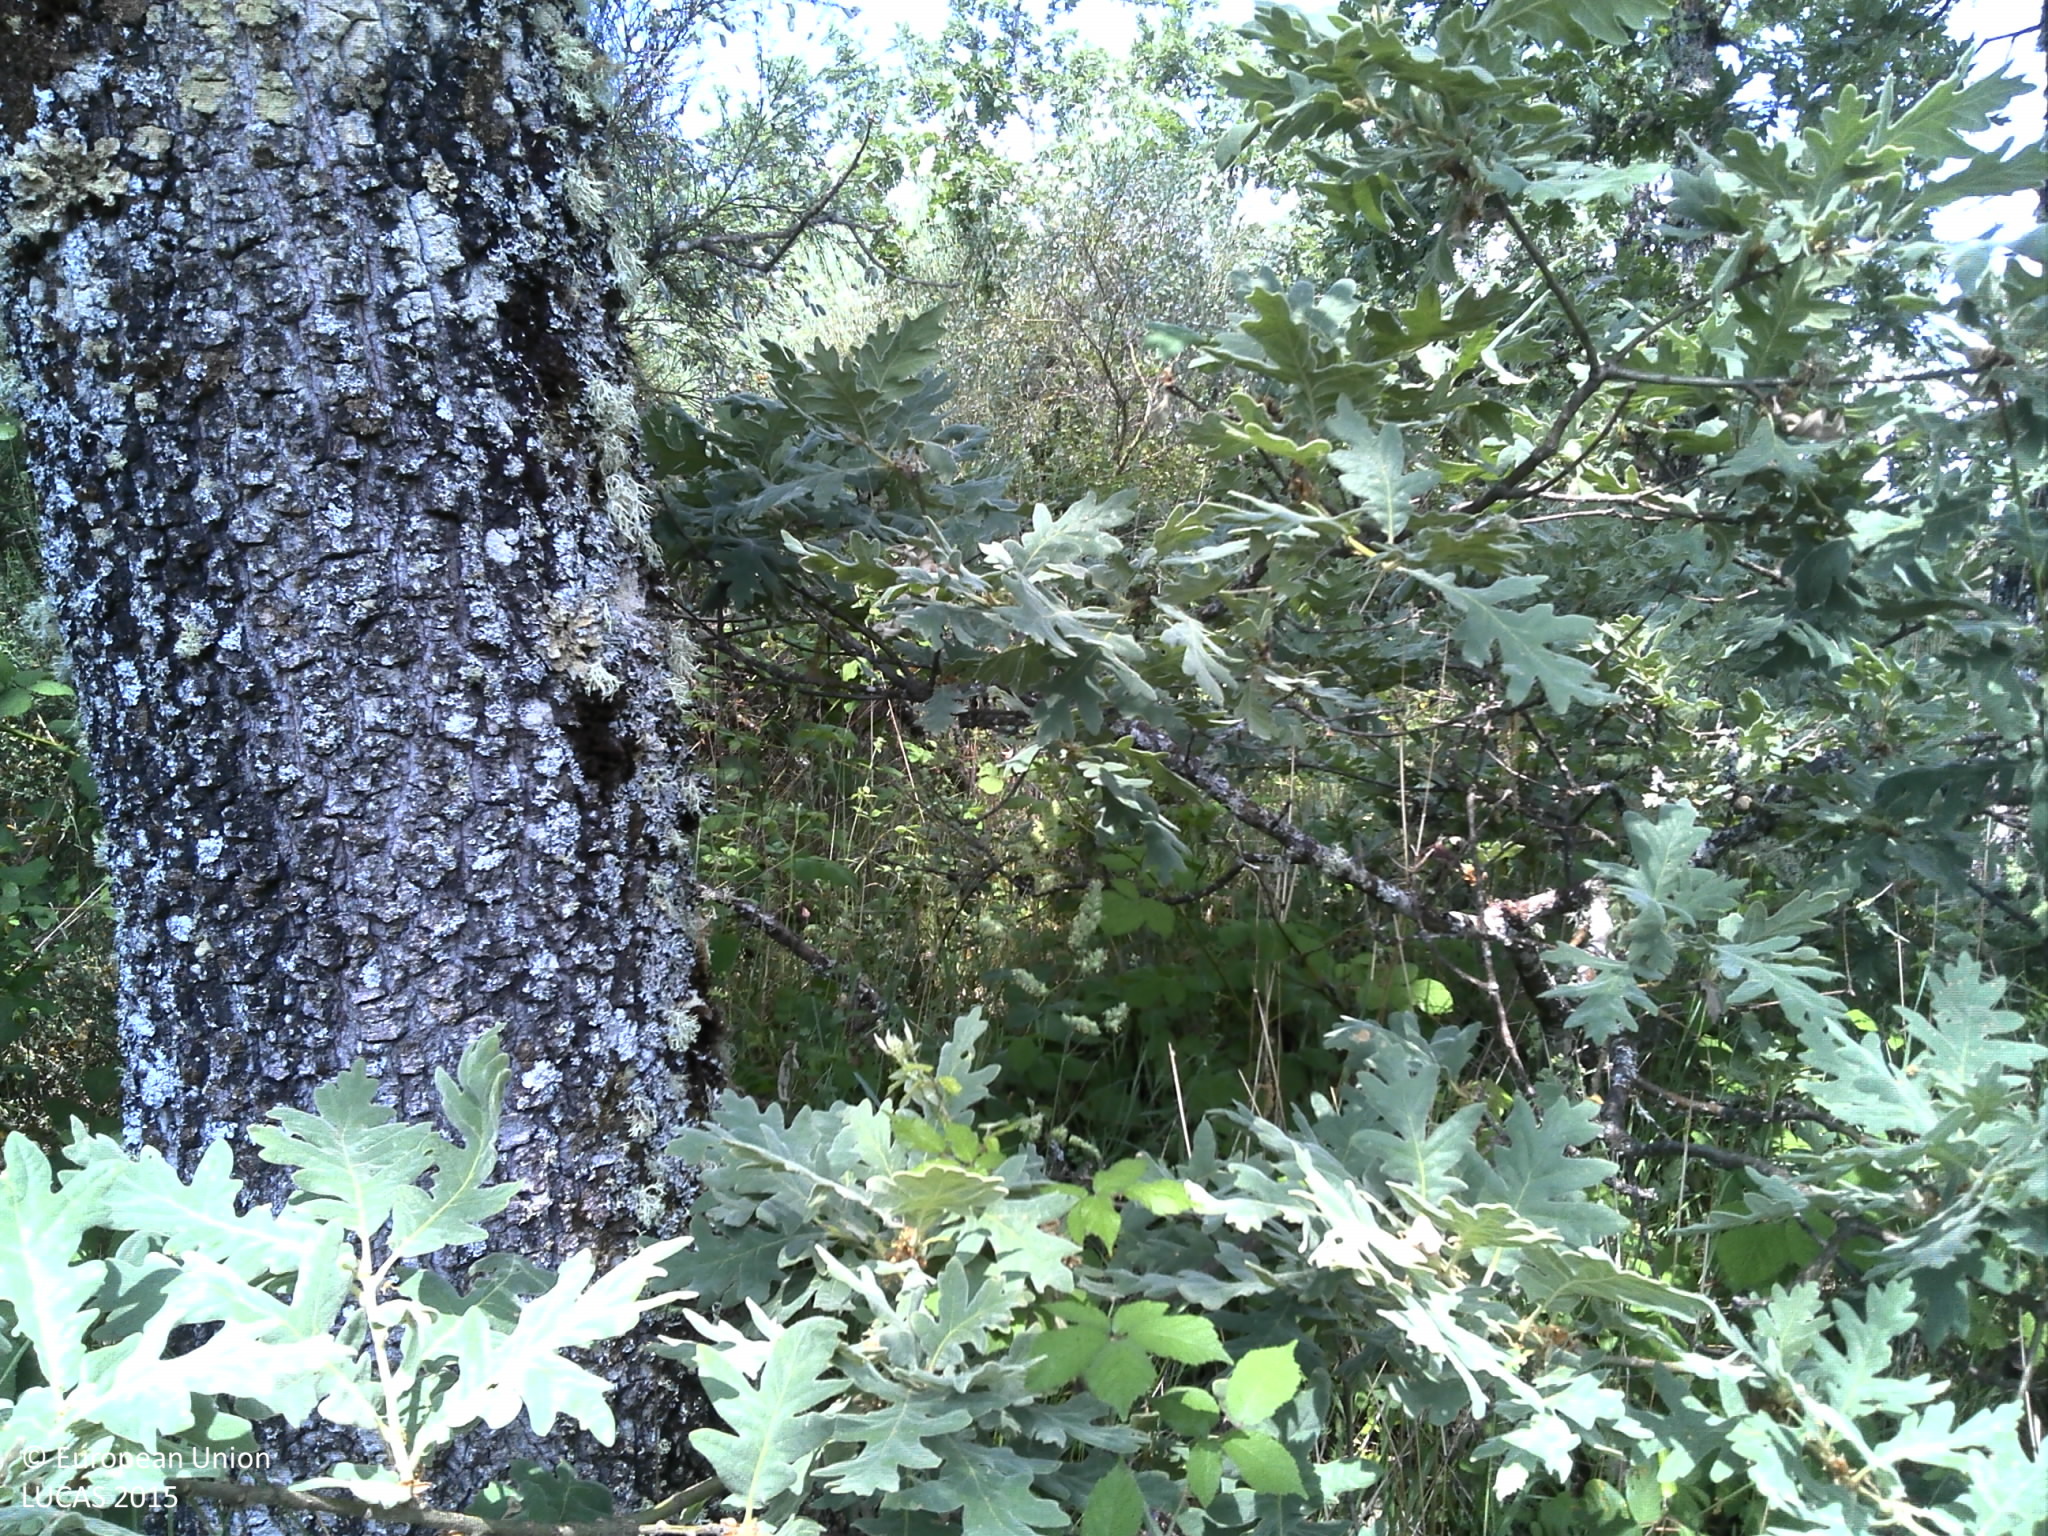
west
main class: Woodland
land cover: Broadleaved woodland
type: thermophilous deciduous forest
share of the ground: 50 - 75 %
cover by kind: broadleaved forest trees 50 %, shrubs 20 %, herbaceous plants 20 %, unconsolidated bare surface 10 %
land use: Abandoned areas
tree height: > 5 m
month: June
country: PT
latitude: 41.4542
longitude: -7.5702
